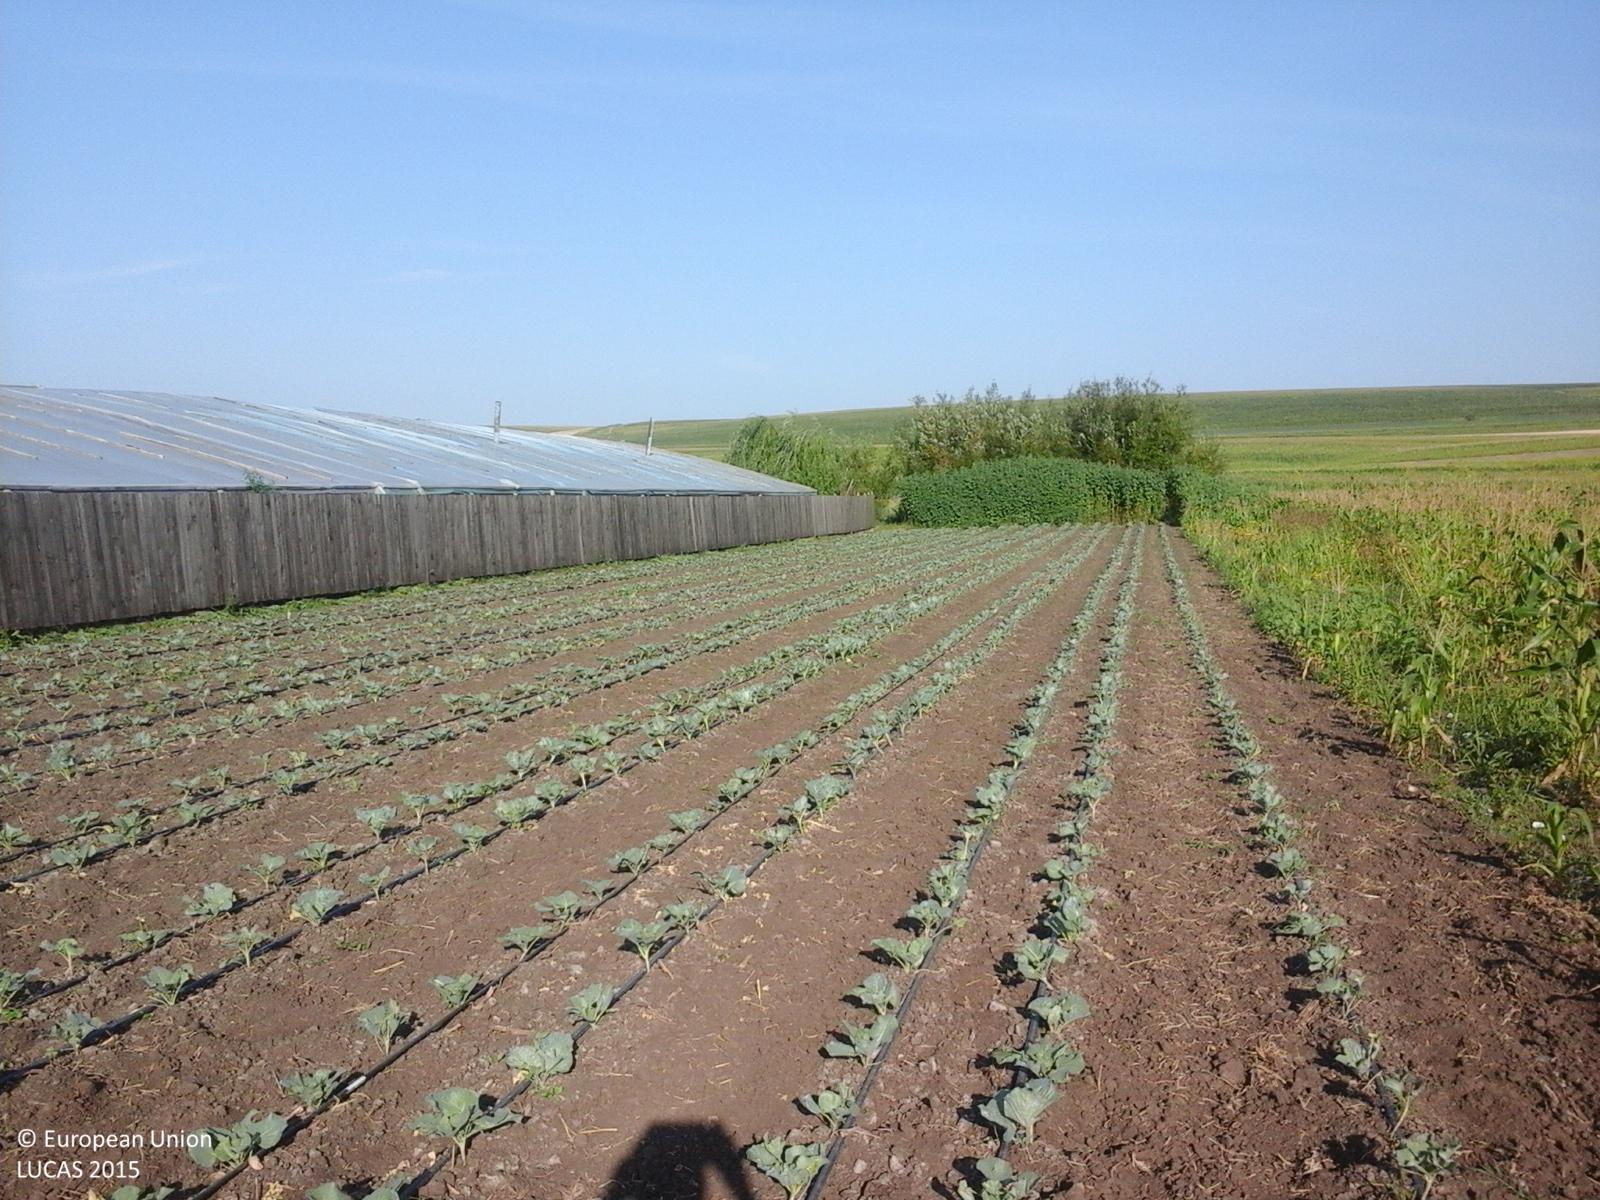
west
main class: Cropland
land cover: Other fresh vegetables
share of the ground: 10 - 25 %
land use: Agriculture (excluding fallow land and kitchen gardens)
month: July
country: RO
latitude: 45.9200
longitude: 27.4201
